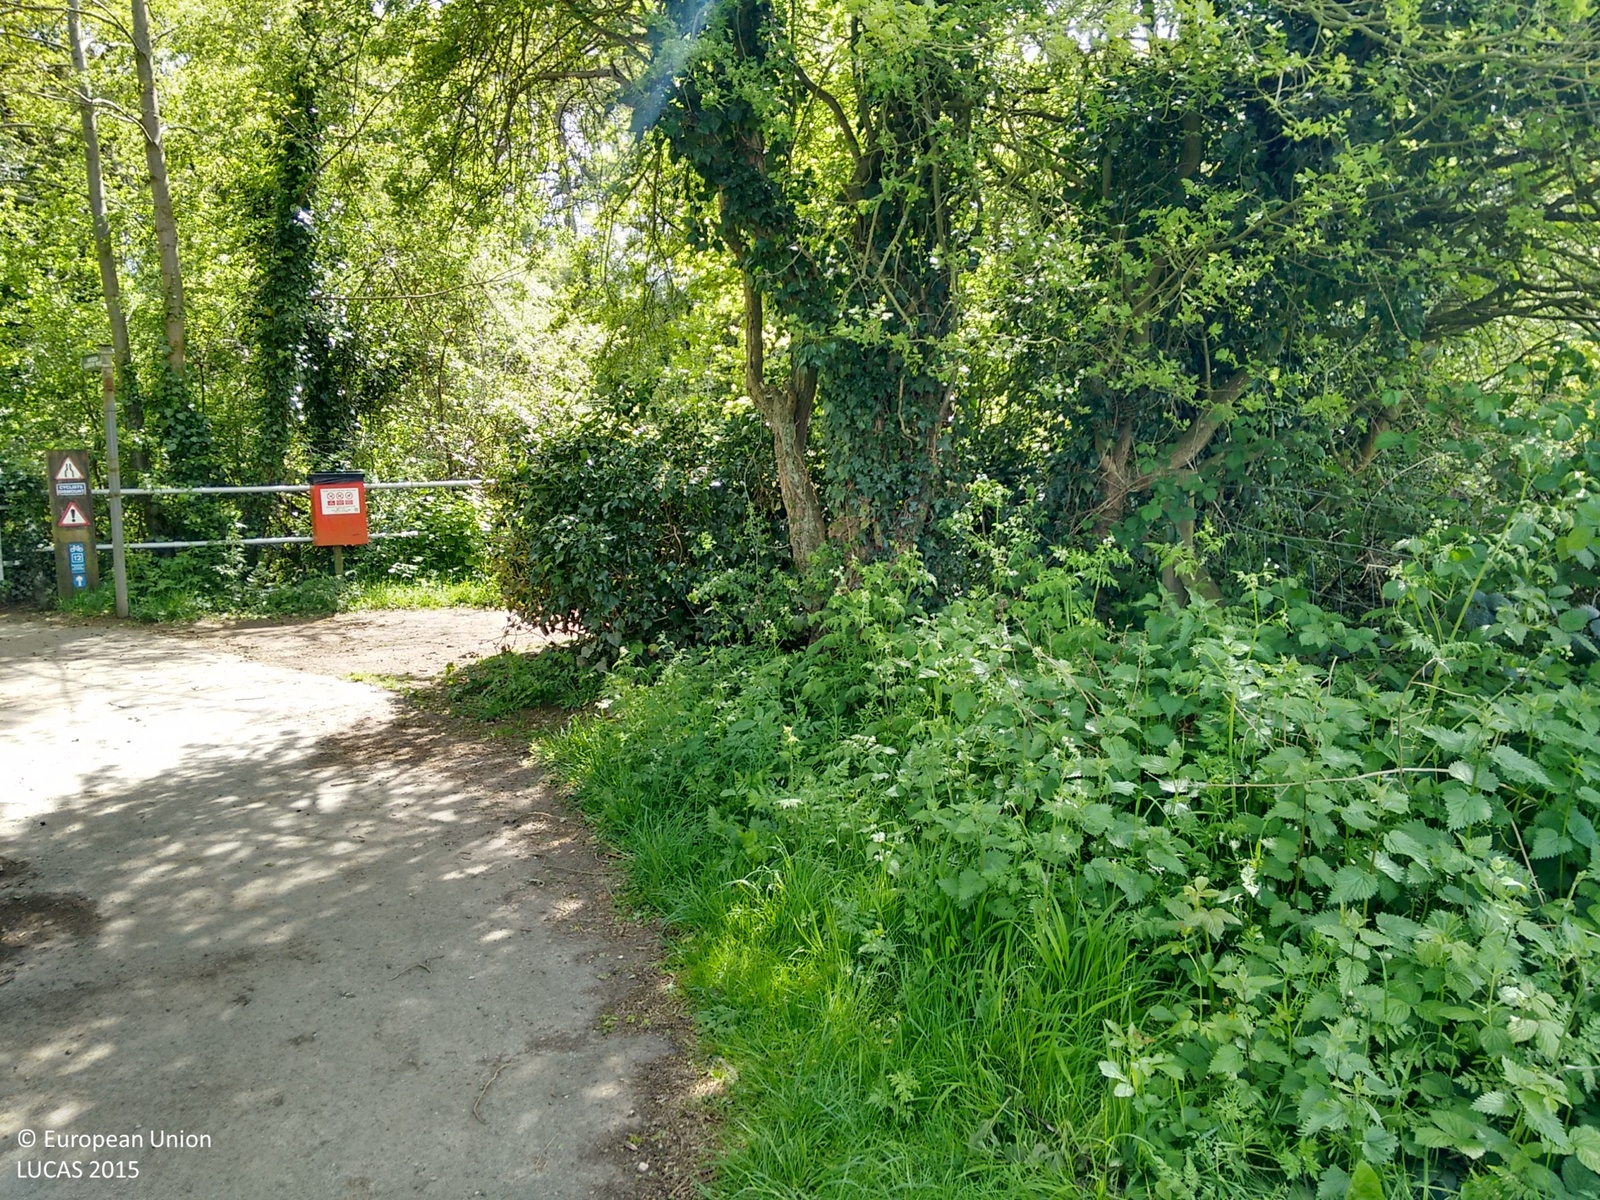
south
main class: Woodland
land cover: Broadleaved woodland
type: mesophytic deciduous forest
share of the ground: > 75 %
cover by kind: broadleaved forest trees 90 %, shrubs 10 %
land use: Semi-natural and natural areas not in use
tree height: > 5 m
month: May
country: GB
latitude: 51.1966
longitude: 0.2529
